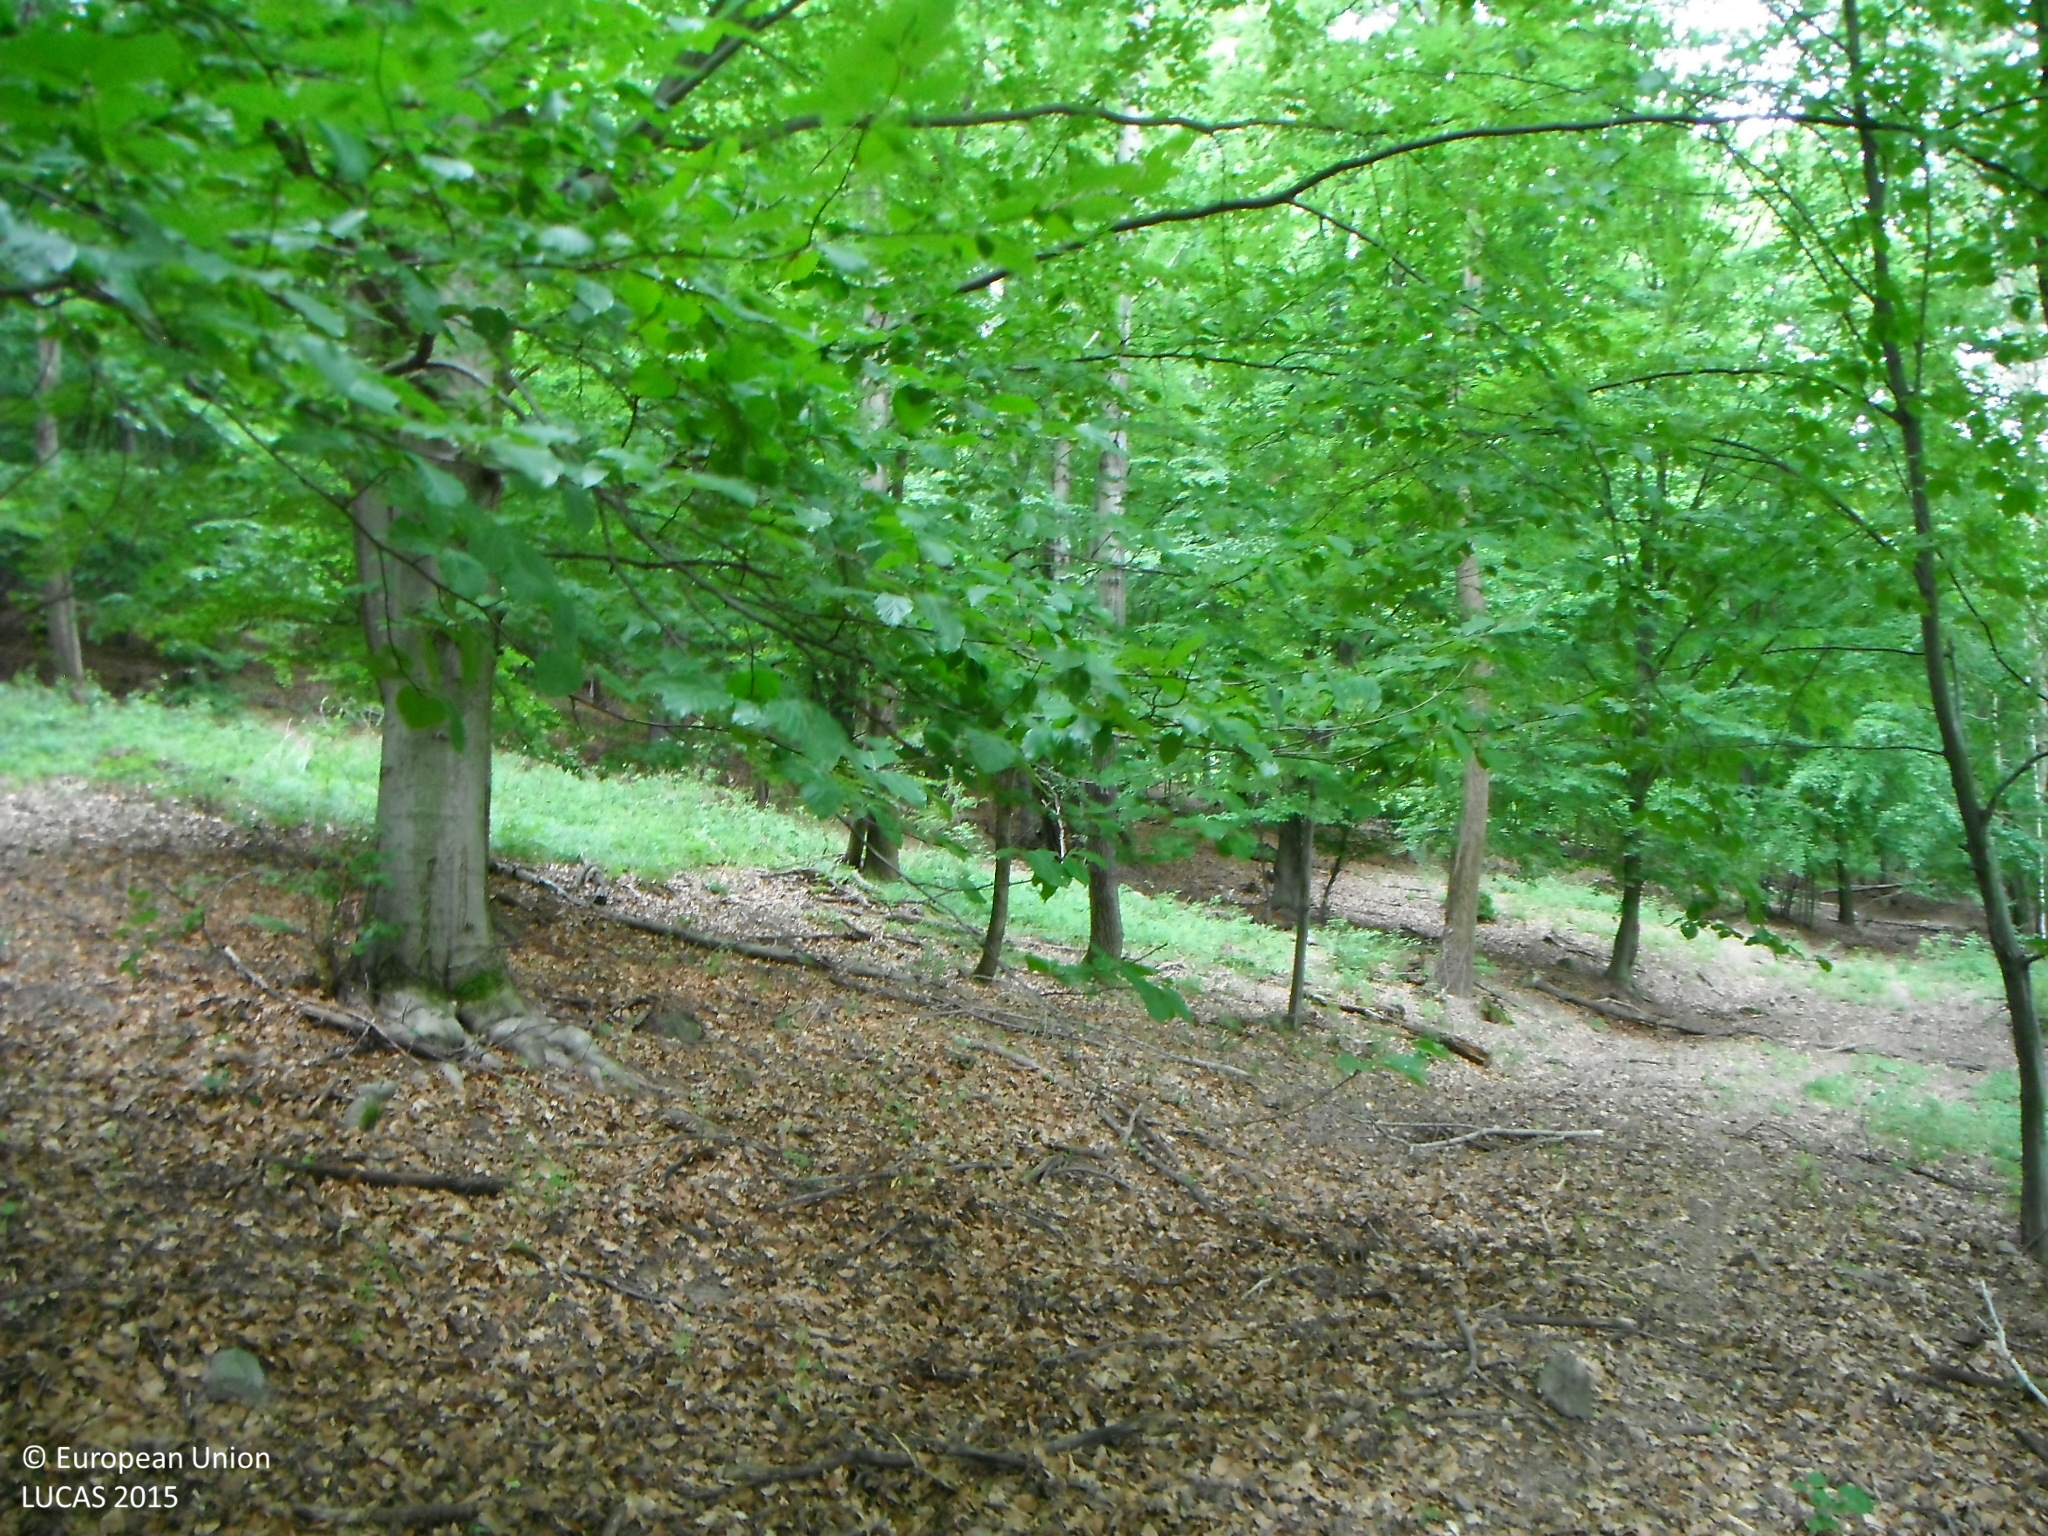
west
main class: Woodland
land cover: Broadleaved woodland
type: mesophytic deciduous forest
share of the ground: > 75 %
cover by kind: broadleaved forest trees 100 %
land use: Forestry
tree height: > 5 m
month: July
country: SK
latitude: 48.3307
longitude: 18.9358
